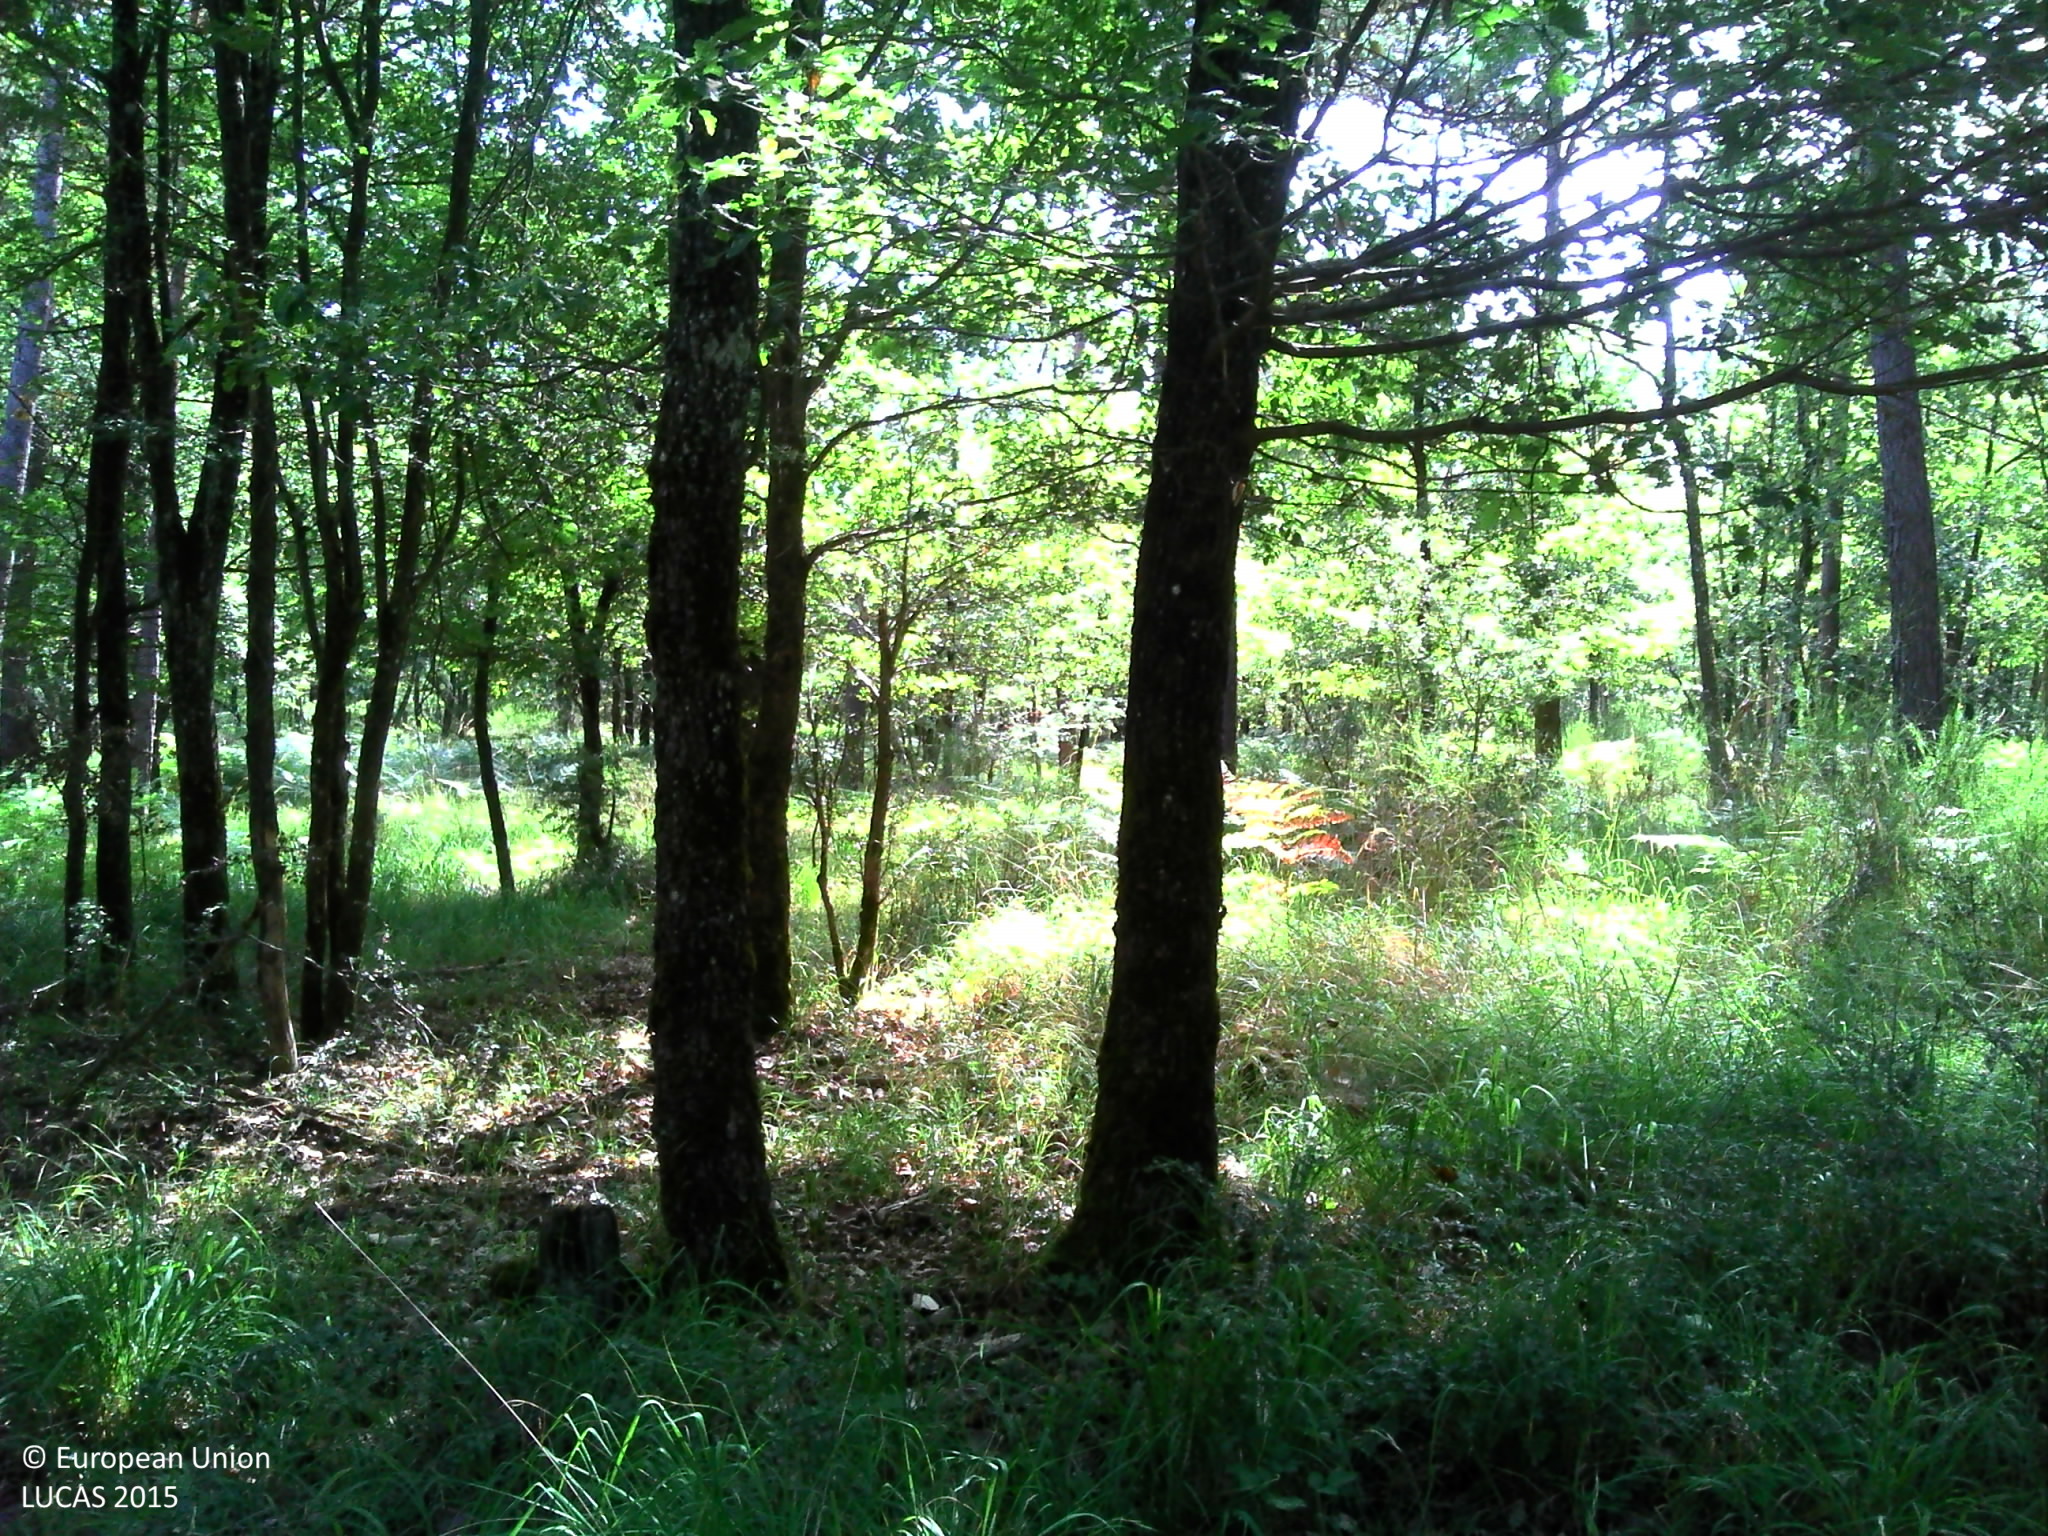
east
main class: Woodland
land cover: Pine dominated mixed woodland
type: hemiboreal forest and nemoral coniferous forest and mixed broadleaved-coniferous forest
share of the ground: > 75 %
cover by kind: herbaceous plants 45 %, broadleaved forest trees 30 %, coniferous forest trees 25 %
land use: Forestry
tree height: > 5 m
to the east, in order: Pine dominated mixed woodland; Tracks; Pine dominated mixed woodland
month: August
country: FR
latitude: 48.3797
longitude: 2.7132
